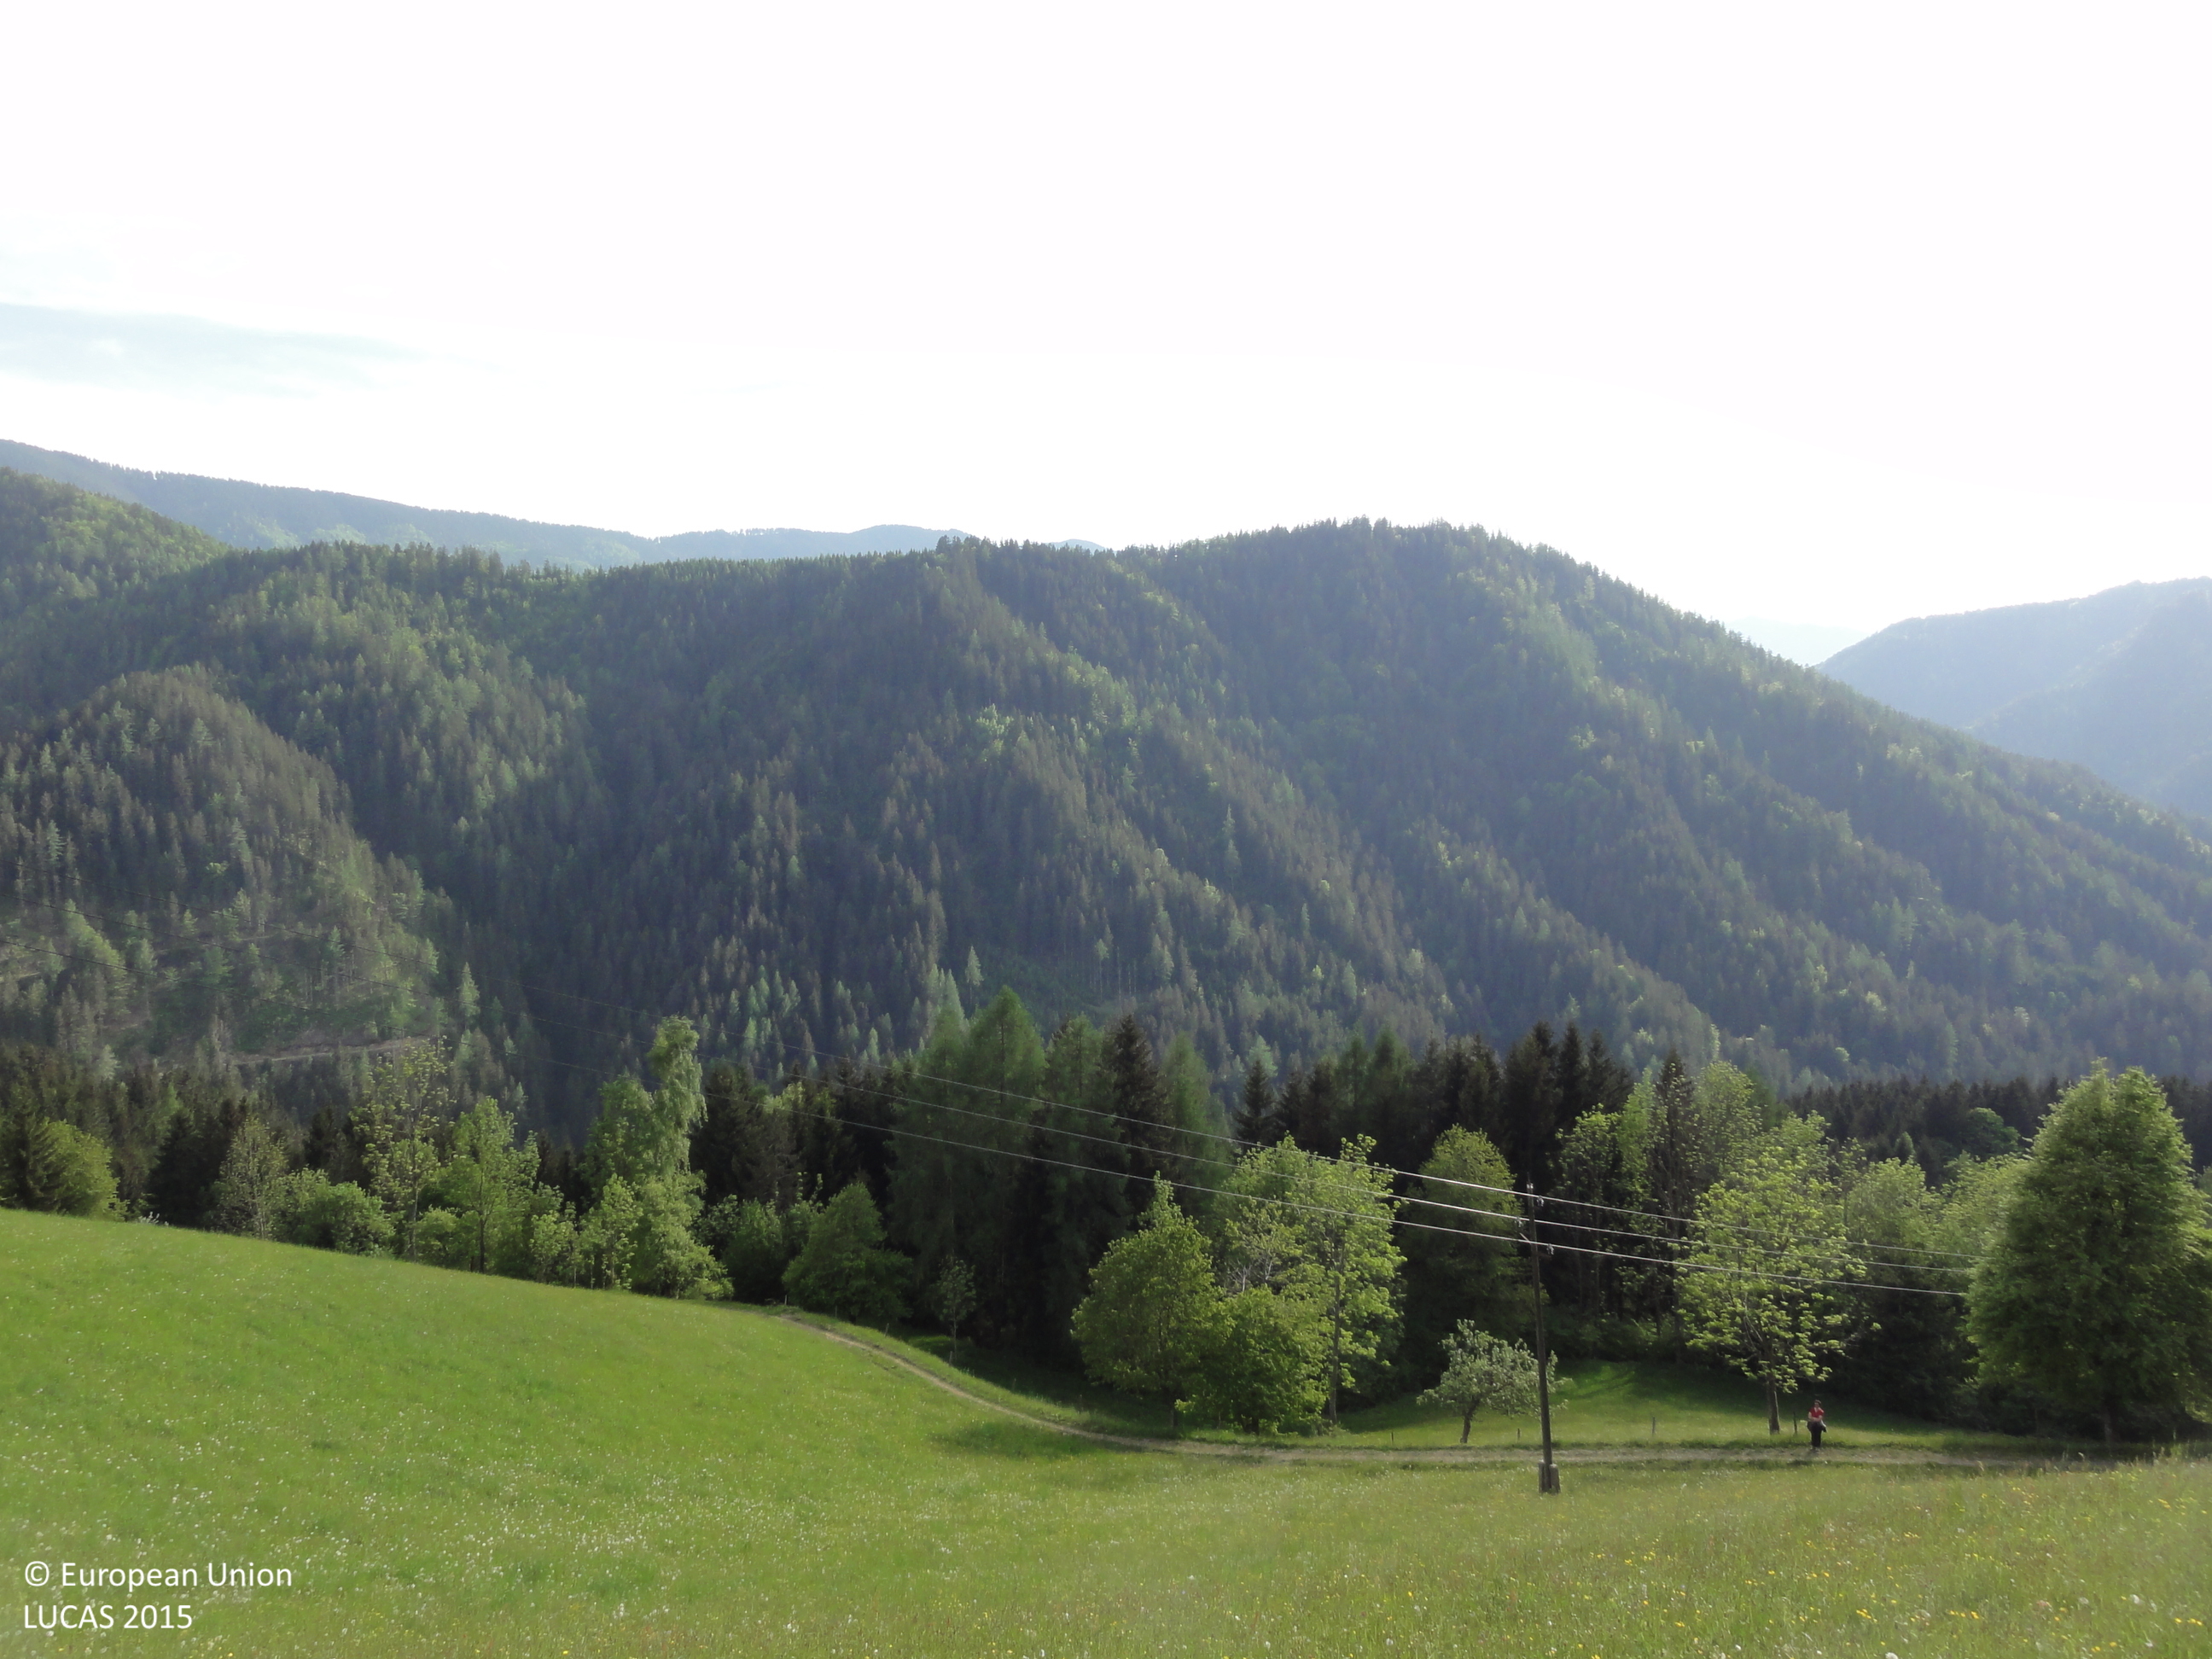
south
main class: Grassland
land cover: Grassland without tree/shrub cover
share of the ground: > 75 %
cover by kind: herbaceous plants 100 %
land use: Agriculture (excluding fallow land and kitchen gardens)
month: May
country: SI
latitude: 46.4552
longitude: 14.9061
